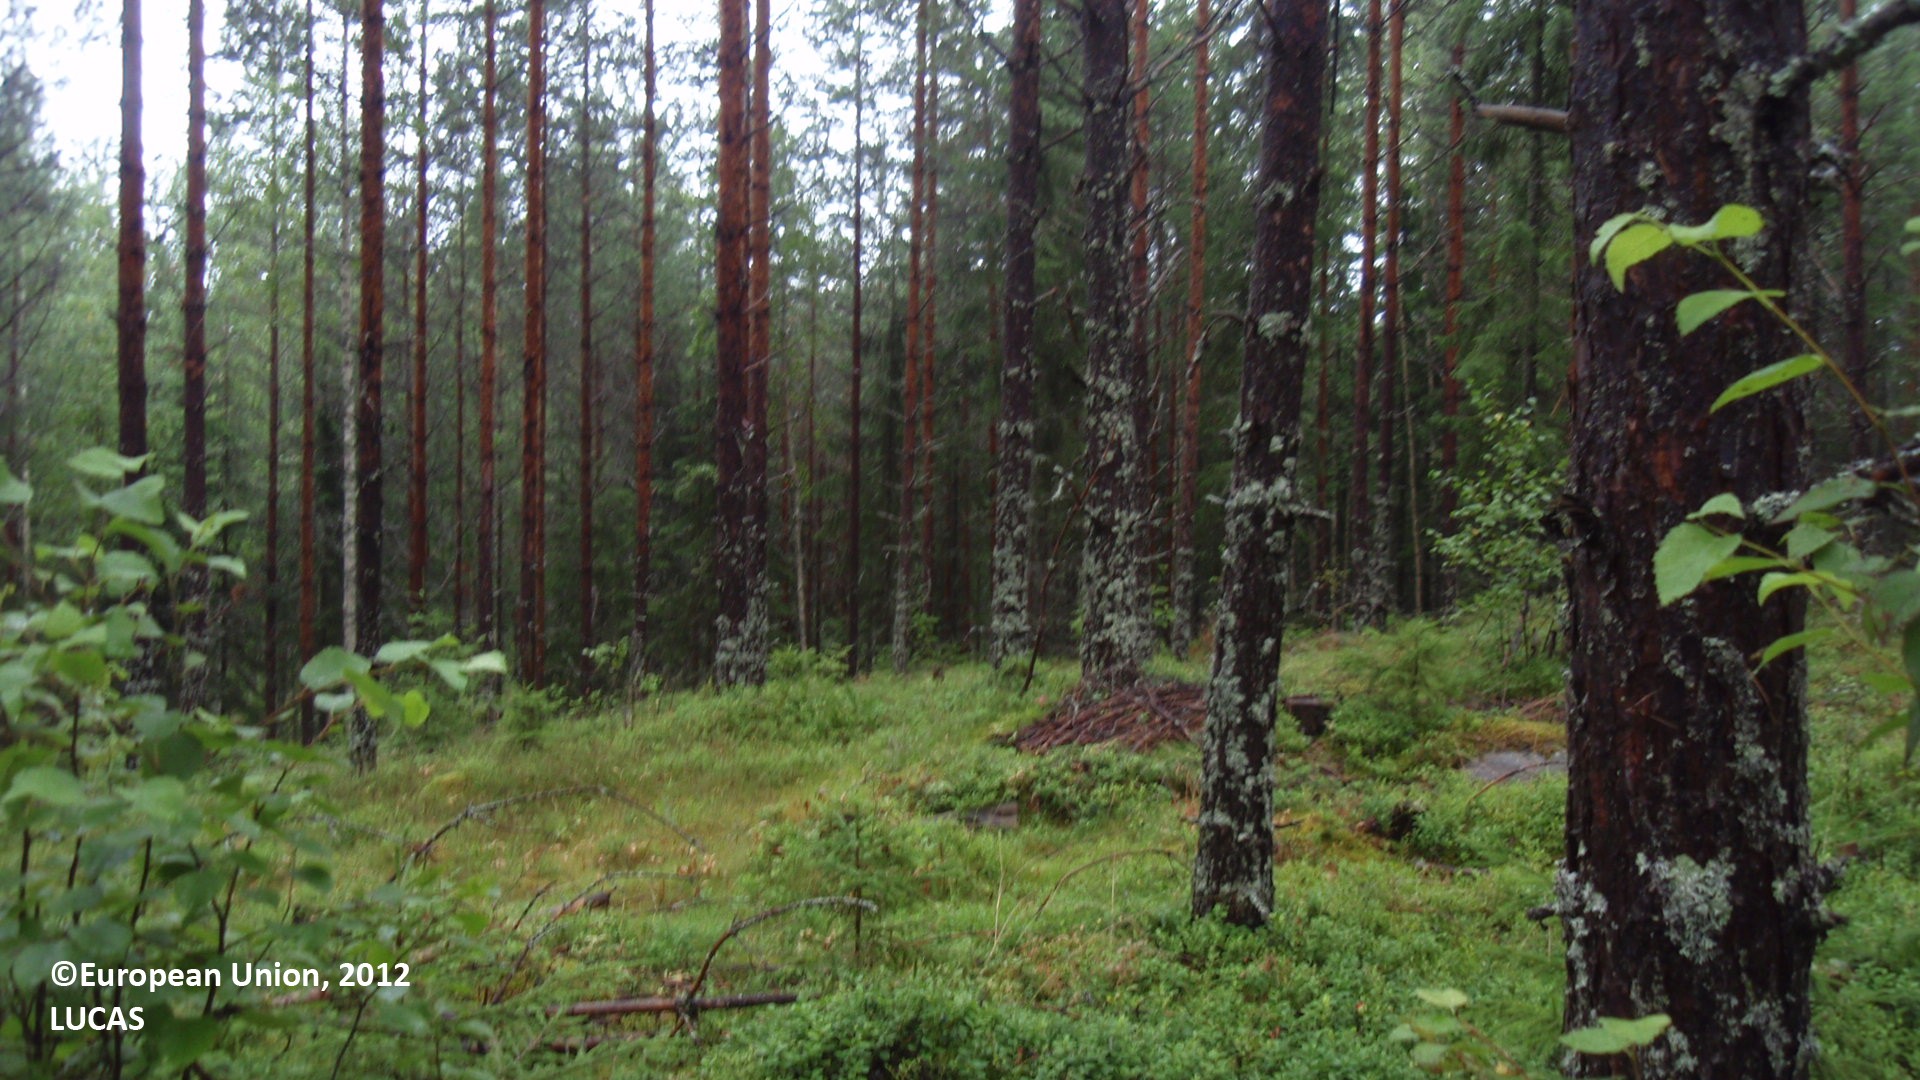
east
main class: Woodland
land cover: Pine dominated coniferous woodland
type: boreal forest
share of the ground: 50 - 75 %
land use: Forestry
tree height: > 5 m
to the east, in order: Pine dominated coniferous woodland; Spruce dominated mixed woodland; Ditches and canals; Pine dominated coniferous woodland; Spruce dominated mixed woodland; Ditches and canals; Spruce dominated mixed woodland; Pine dominated mixed woodland; Ditches and canals; Pine dominated mixed woodland; Broadleaved woodland; Pine dominated mixed woodland
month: August
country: FI
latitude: 61.3244
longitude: 27.1112
